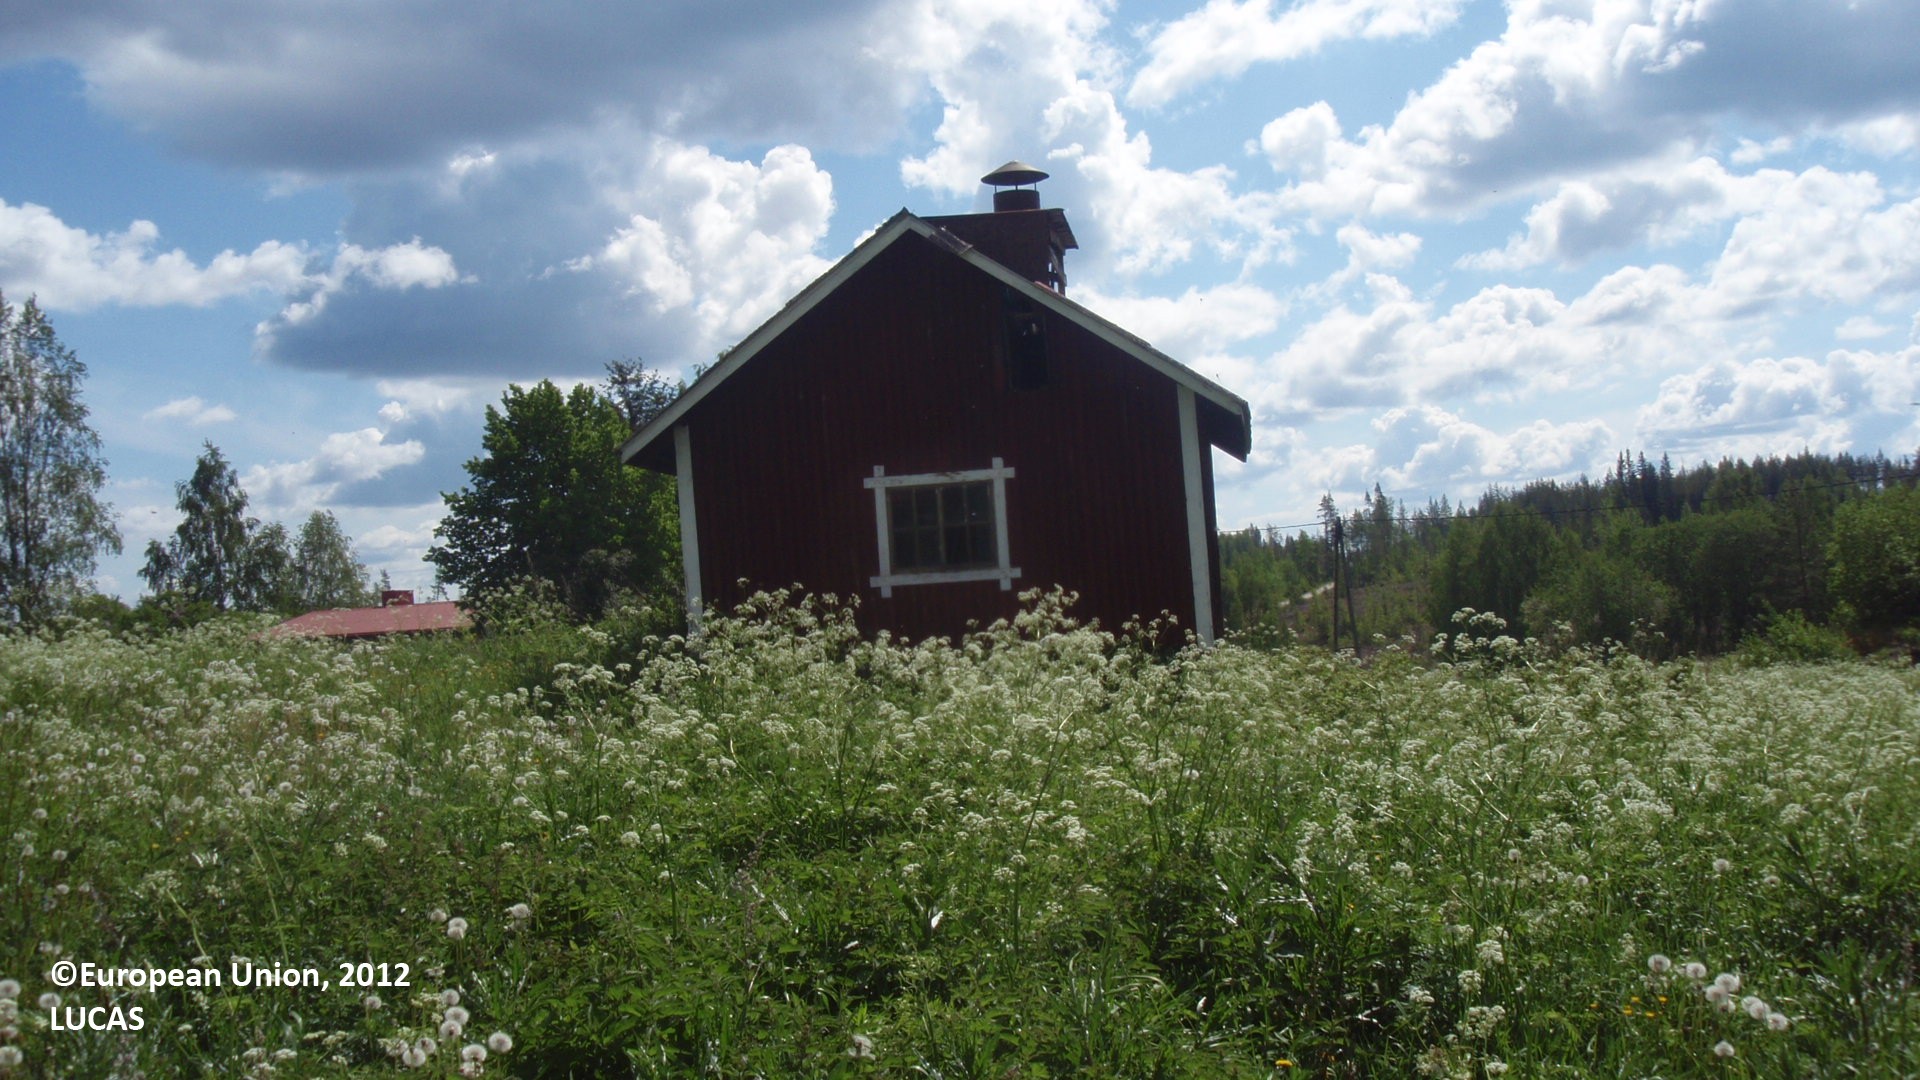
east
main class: Grassland
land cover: Spontaneously vegetated surfaces
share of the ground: > 75 %
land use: Fallow land
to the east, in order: Spontaneously vegetated surfaces; Artificial constructions in urban areas; Spontaneously vegetated surfaces; Abandoned hedges; Ditches and canals; Broadleaved woodland
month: June
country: FI
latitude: 61.8178
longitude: 28.5258
